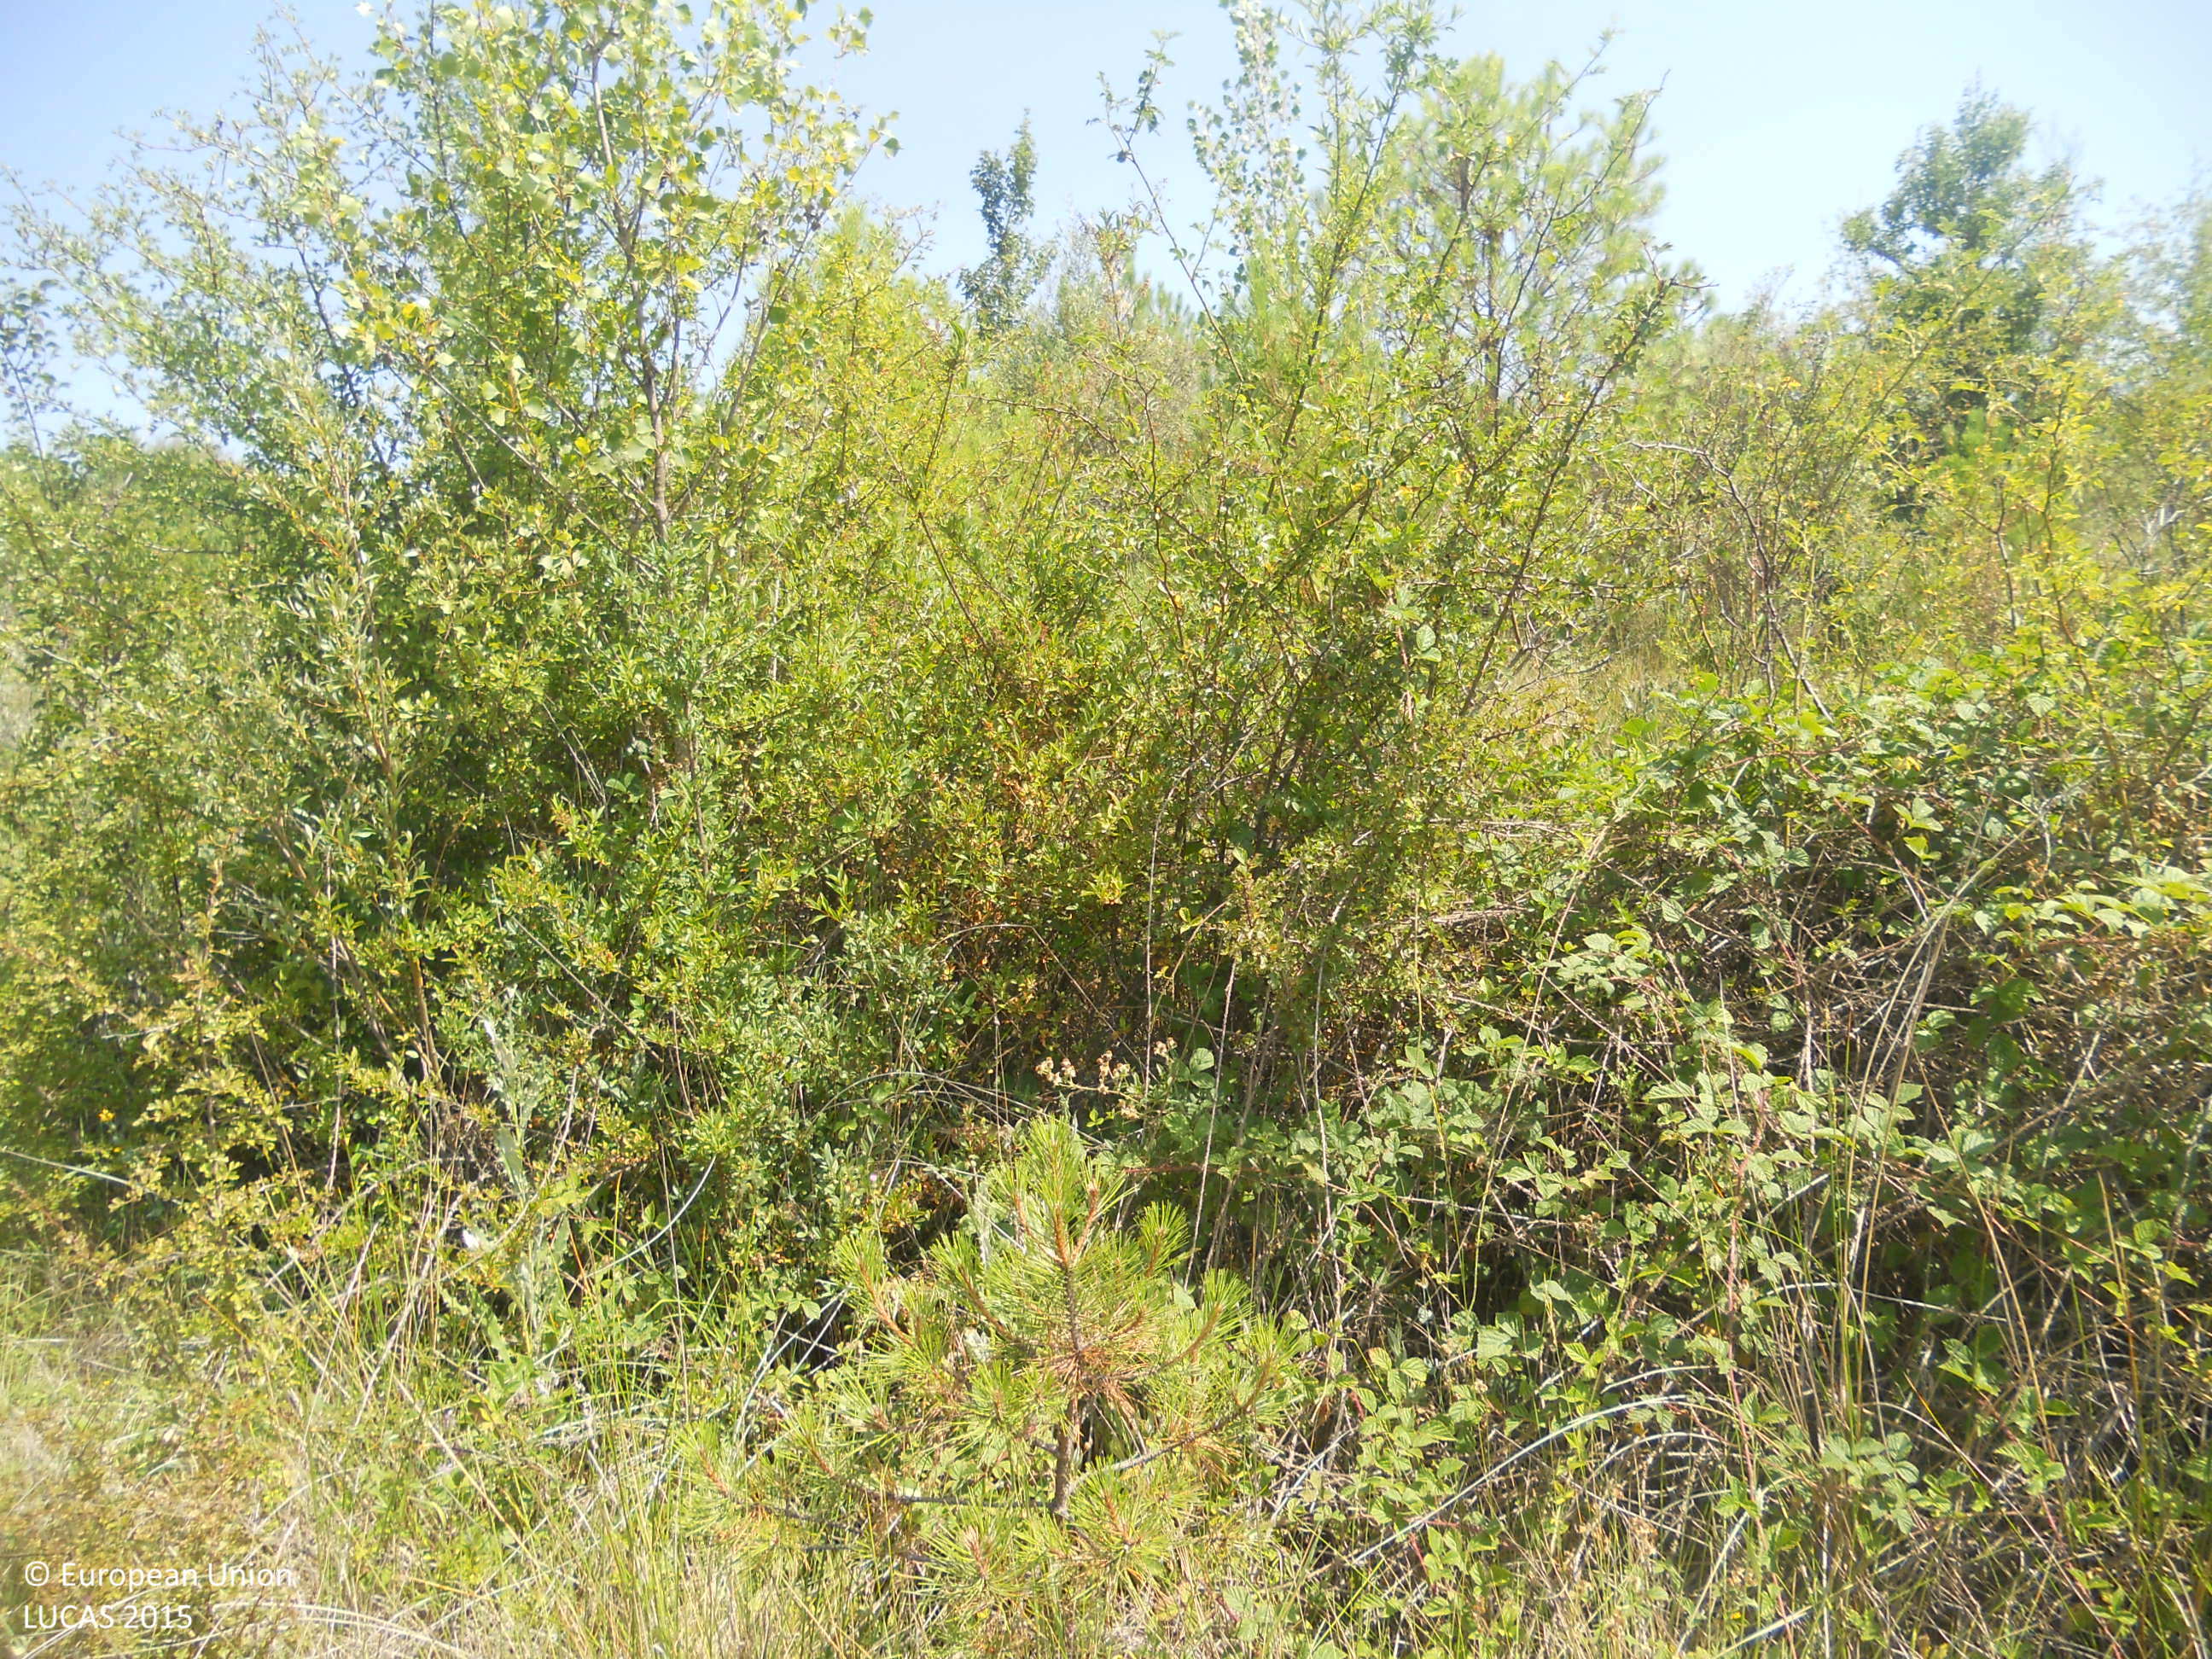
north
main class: Shrubland
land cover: Shrubland with sparse tree cover
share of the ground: > 75 %
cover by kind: shrubs 55 %, herbaceous plants 40 %, coniferous forest trees 5 %
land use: Semi-natural and natural areas not in use
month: July
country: ES
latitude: 42.5932
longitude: -5.3627
